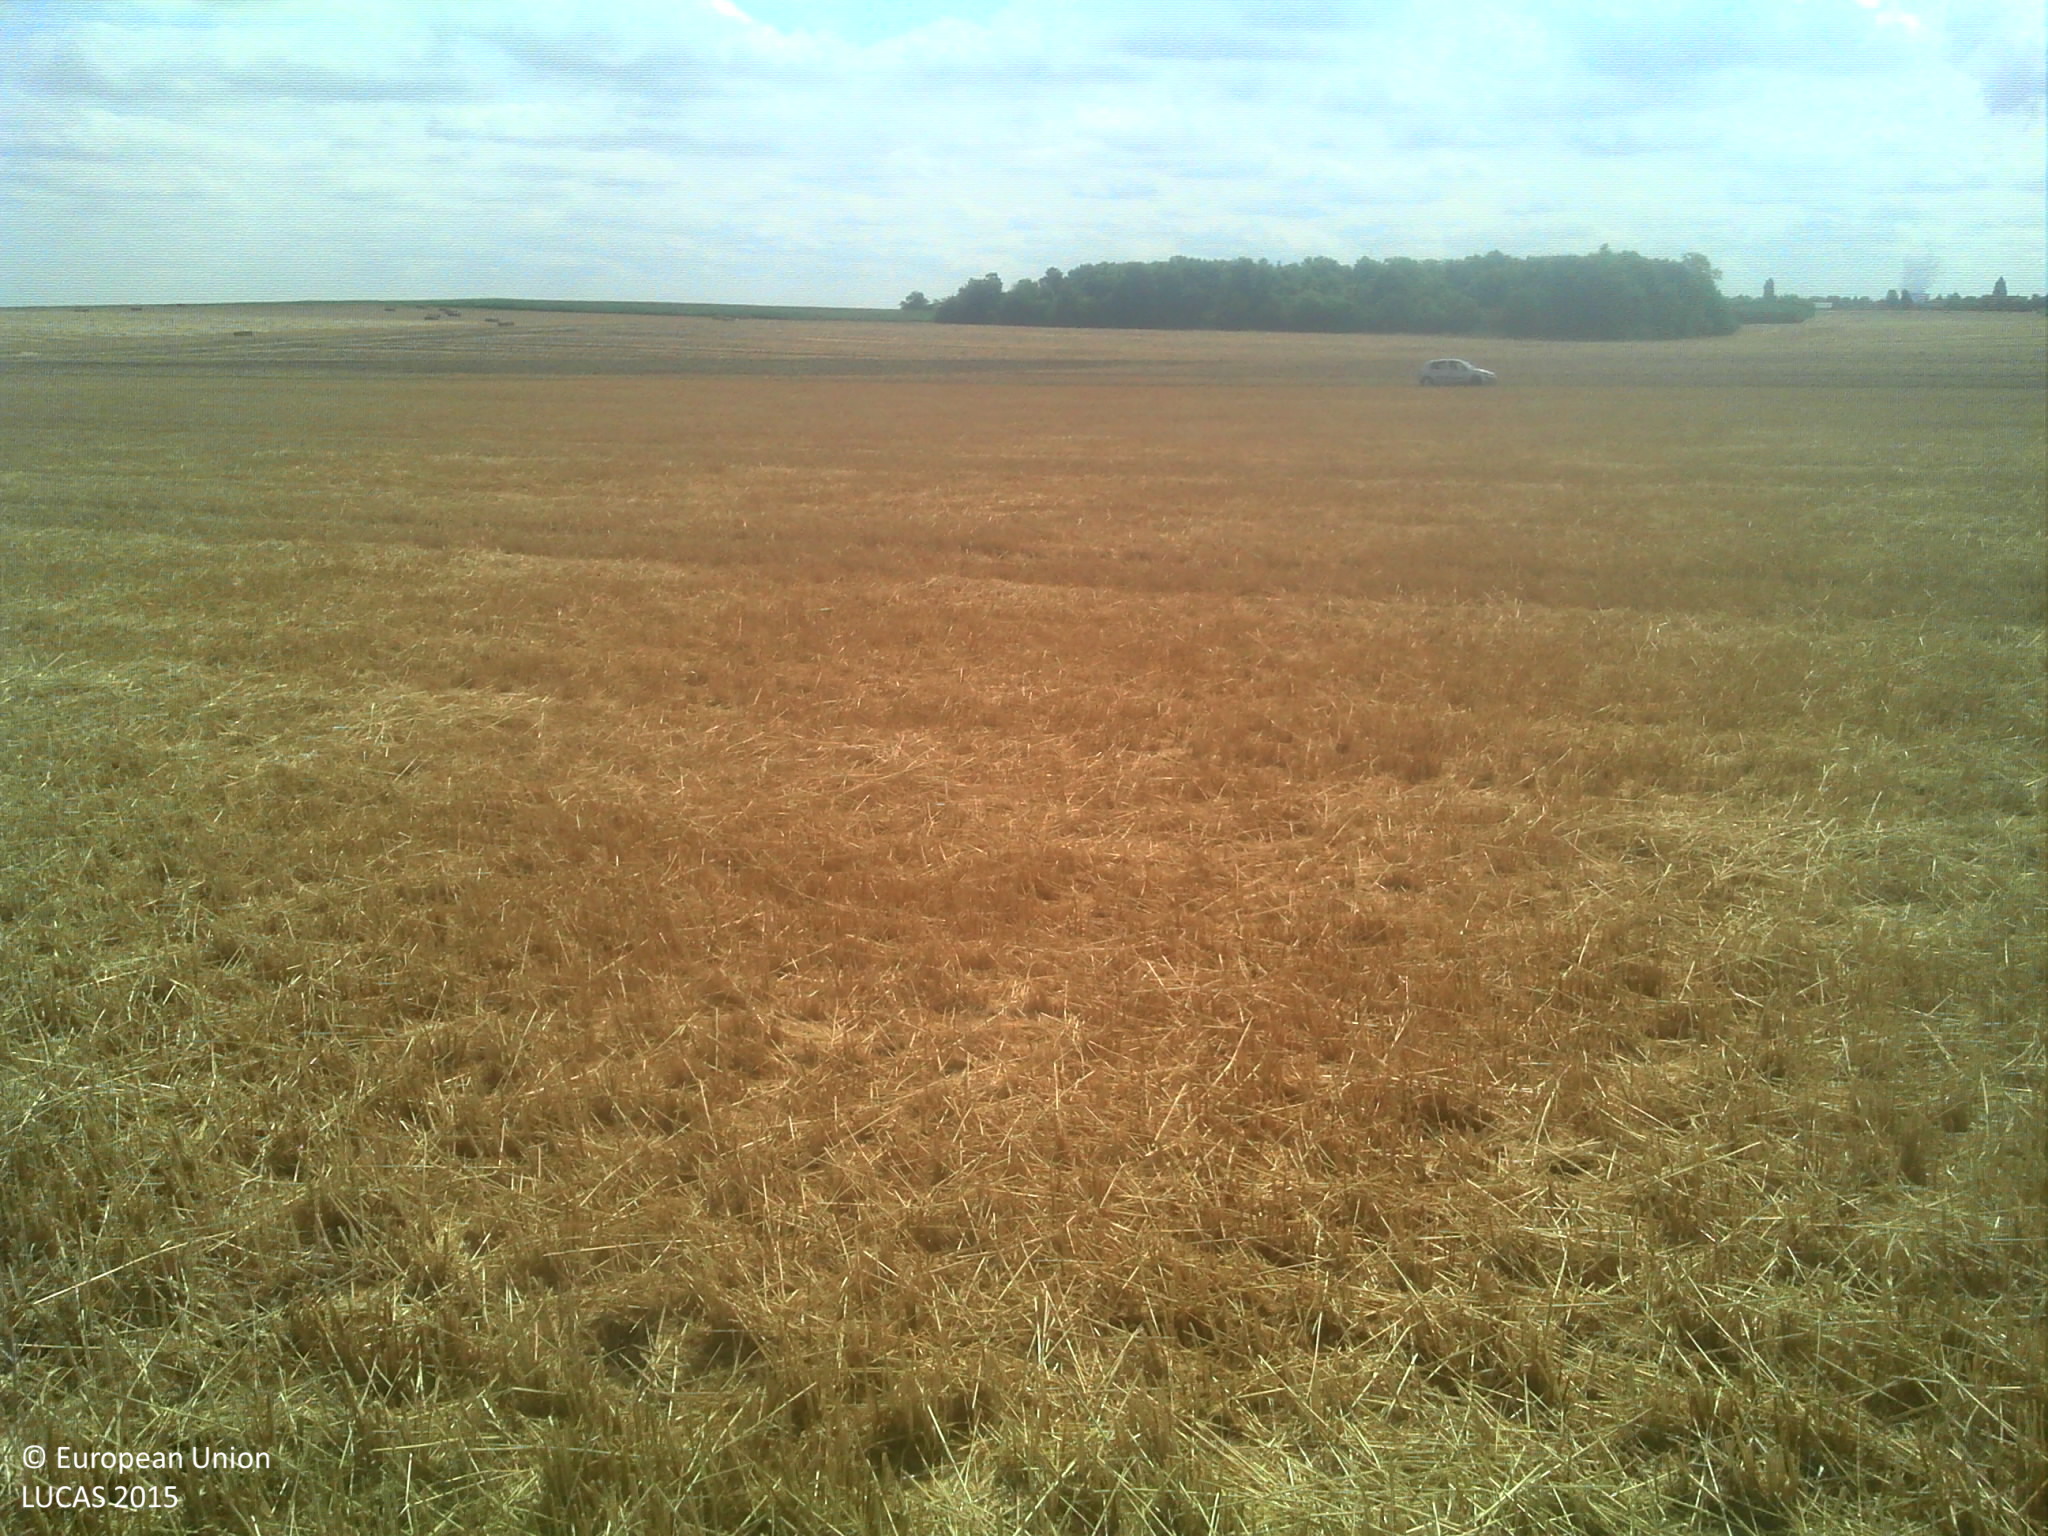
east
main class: Cropland
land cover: Durum wheat
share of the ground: > 75 %
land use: Agriculture (excluding fallow land and kitchen gardens)
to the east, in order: Durum wheat; Tracks; Other bare soil
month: July
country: FR
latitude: 47.7671
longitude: 1.4858
